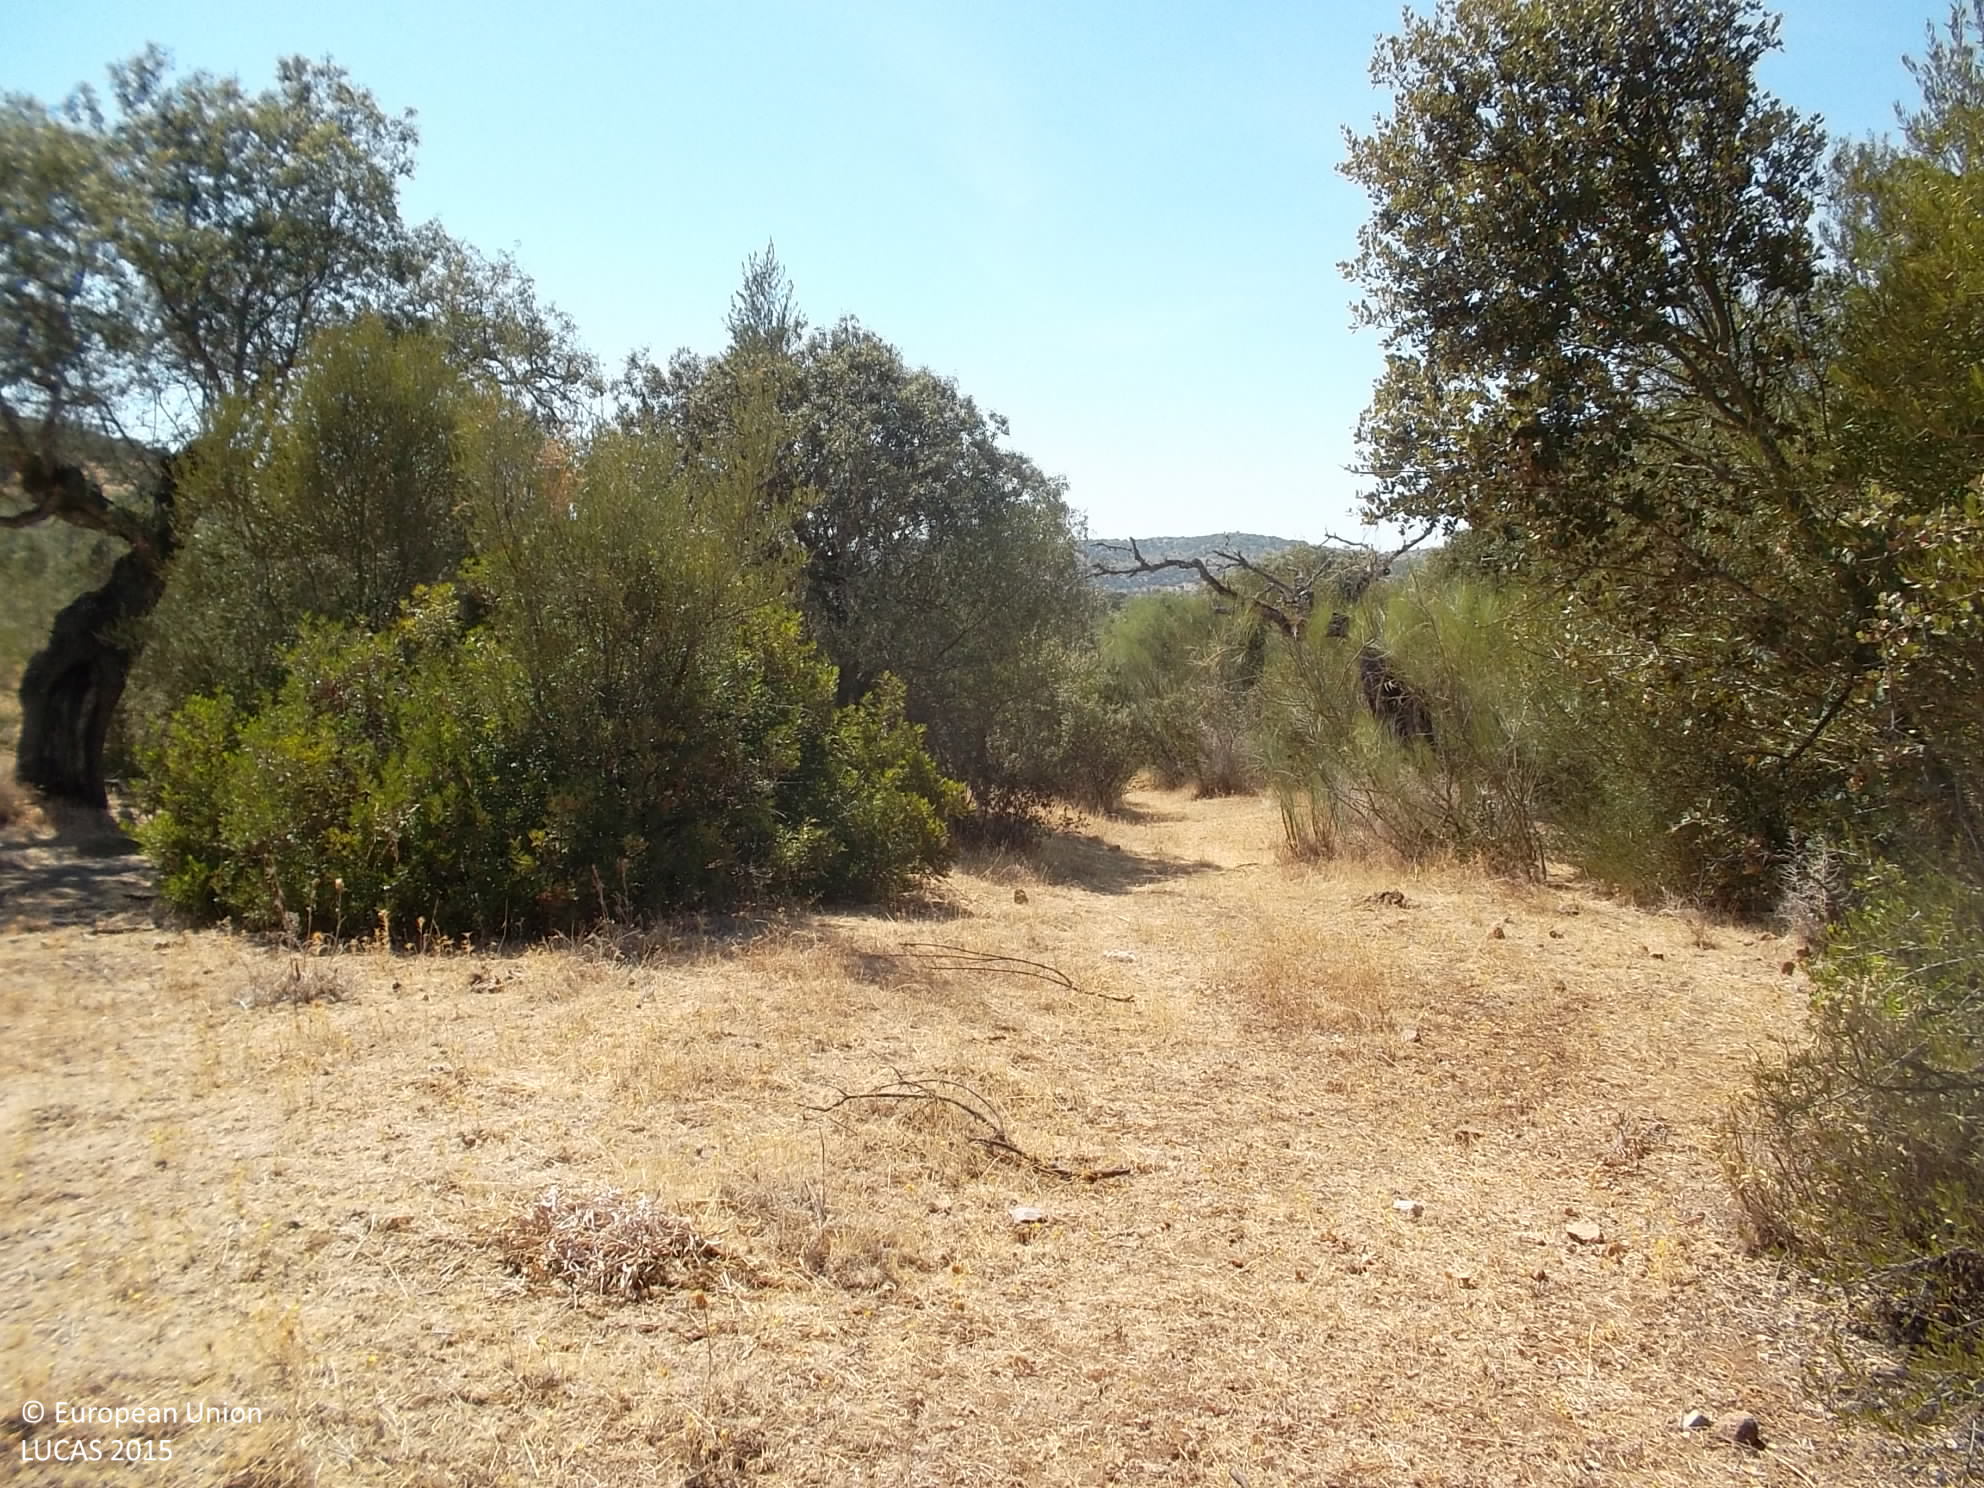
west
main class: Woodland
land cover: Broadleaved woodland
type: broadleaved evergreen forest
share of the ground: 25 - 50 %
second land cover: Grassland without tree/shrub cover
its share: > 75 %
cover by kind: herbaceous plants 55 %, broadleaved forest trees 35 %, shrubs 10 %
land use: Forestry
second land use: Agriculture (excluding fallow land and kitchen gardens)
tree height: < 5 m
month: August
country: ES
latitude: 38.3330
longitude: -6.5593
